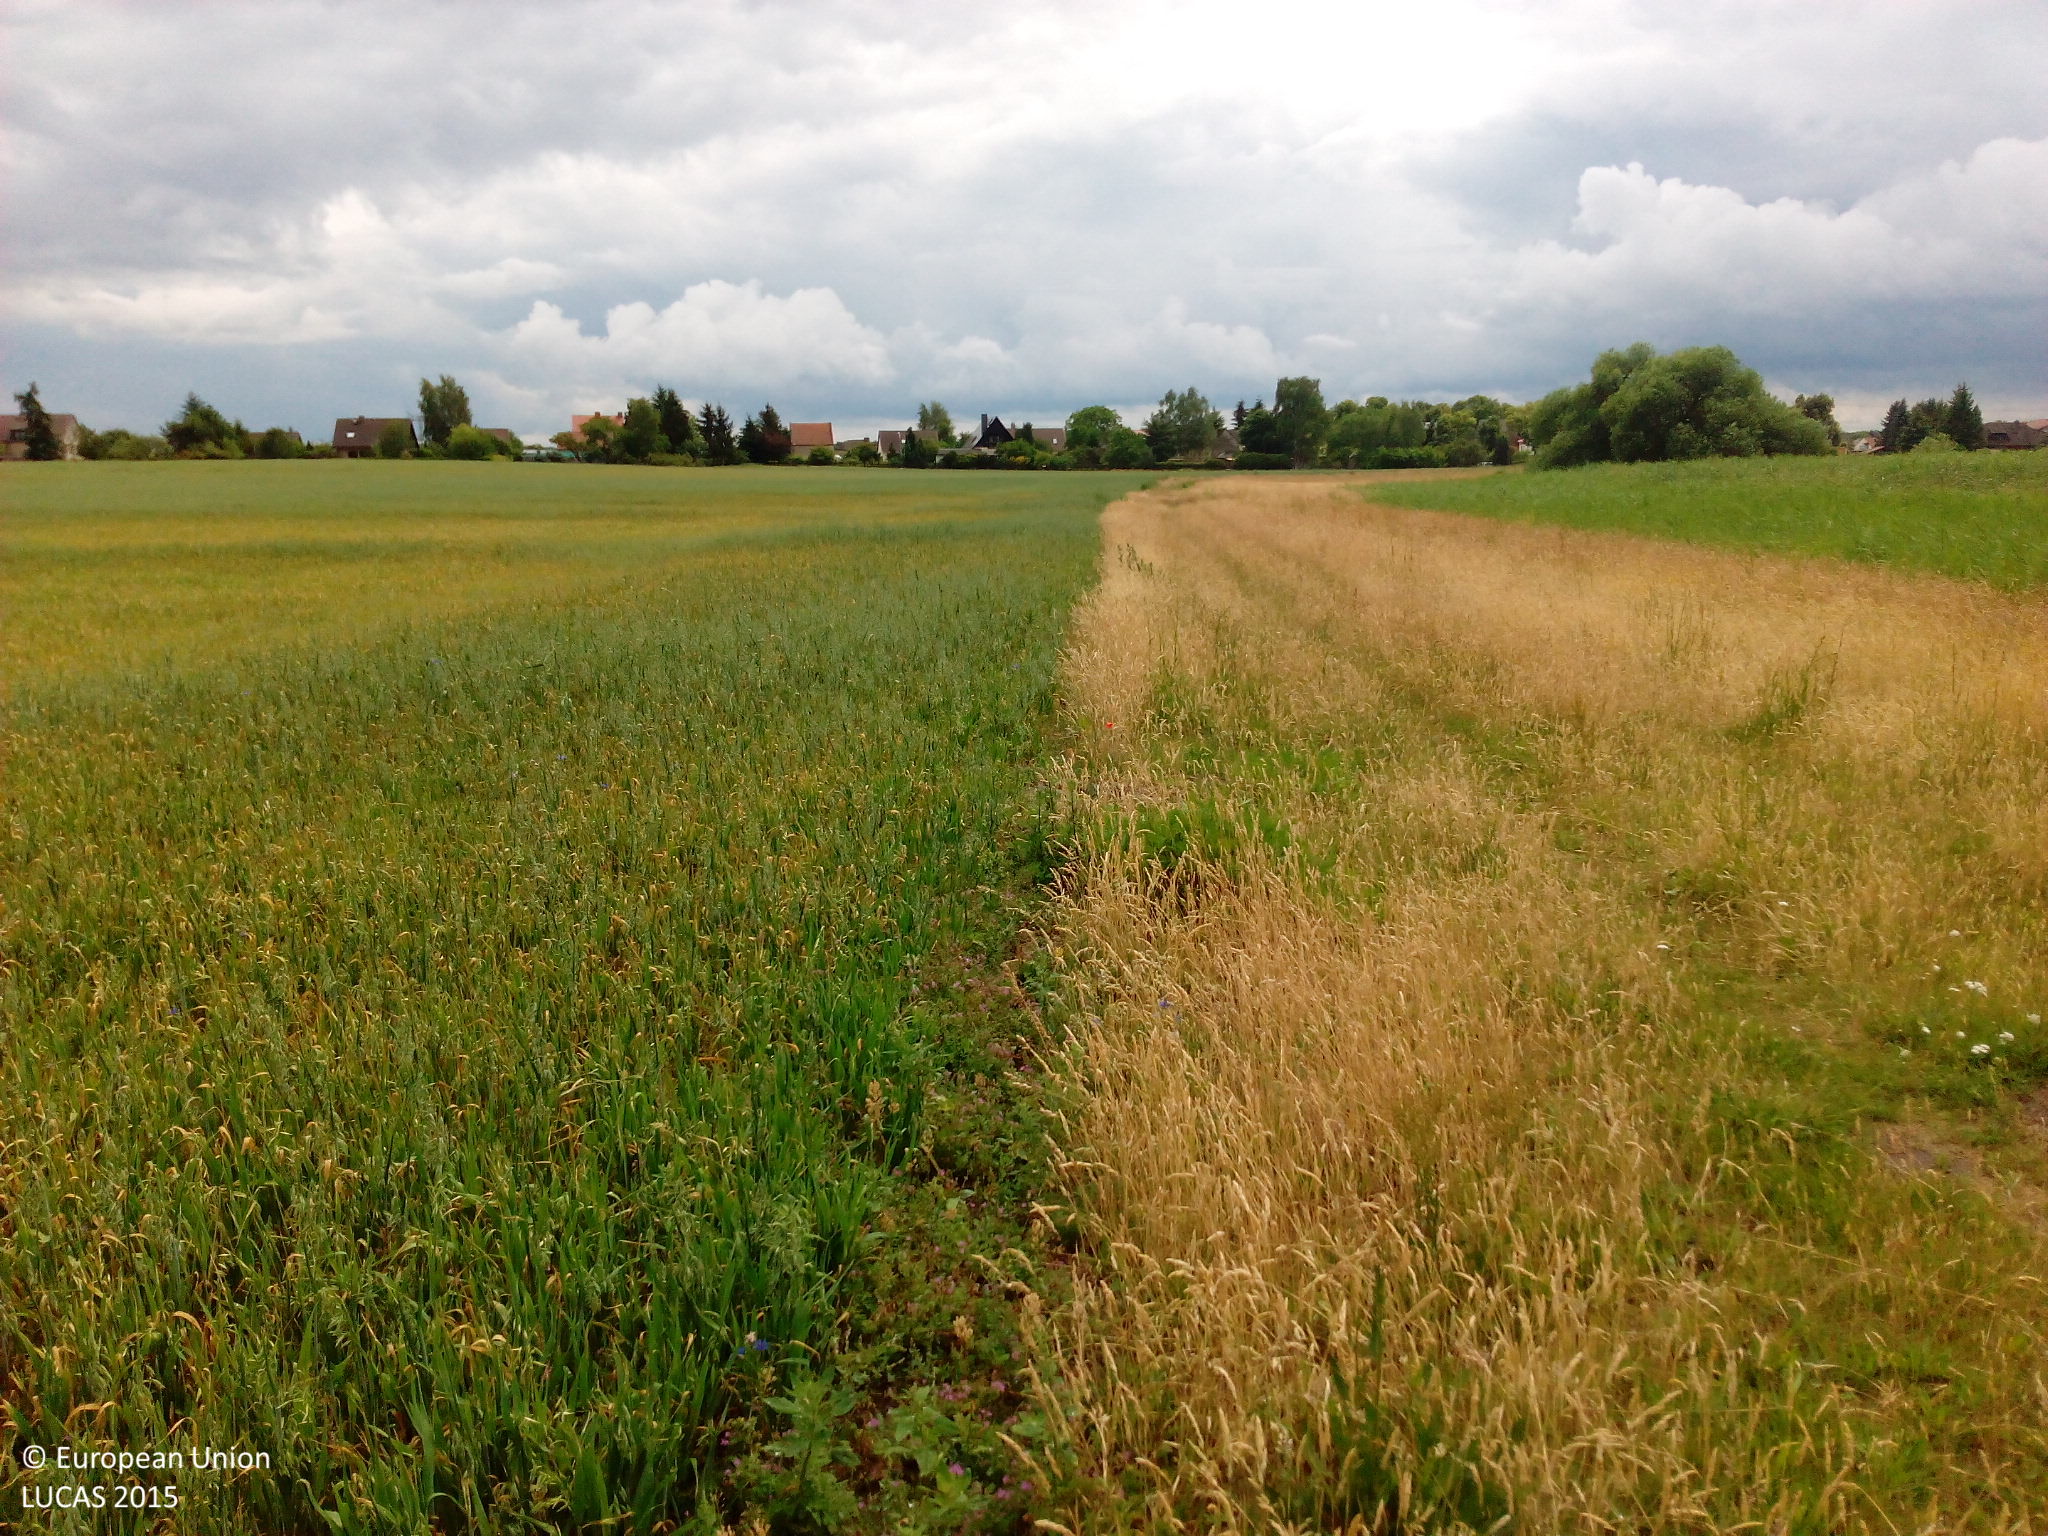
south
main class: Cropland
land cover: Oats
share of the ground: > 75 %
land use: Agriculture (excluding fallow land and kitchen gardens)
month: June
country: DE
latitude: 52.4779
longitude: 12.4584
